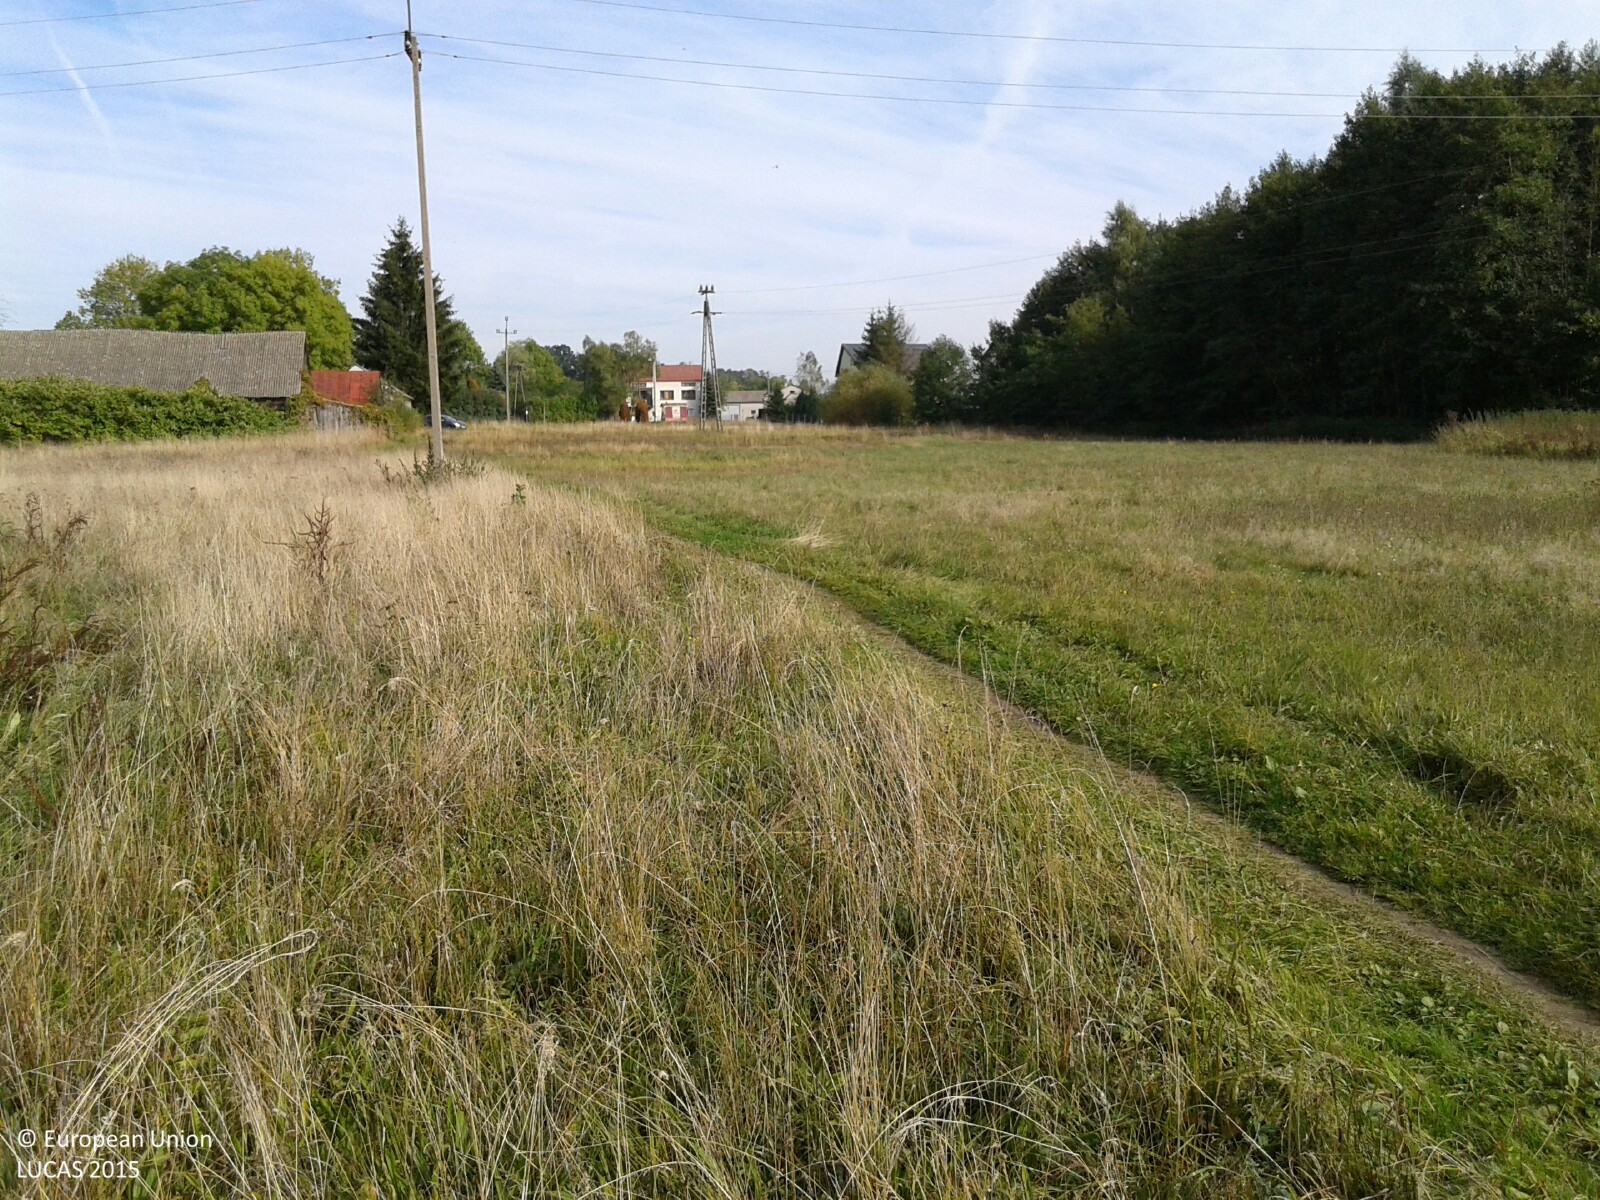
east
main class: Grassland
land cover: Spontaneously vegetated surfaces
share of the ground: > 75 %
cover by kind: herbaceous plants 95 %, shrubs 5 %
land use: Fallow land
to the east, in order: Spontaneously vegetated surfaces; Tracks; Grassland without tree/shrub cover; Electric lines; Grassland without tree/shrub cover; Electric lines; Grassland without tree/shrub cover; Artificial constructions in urban areas
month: September
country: PL
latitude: 52.5874
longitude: 22.1491
